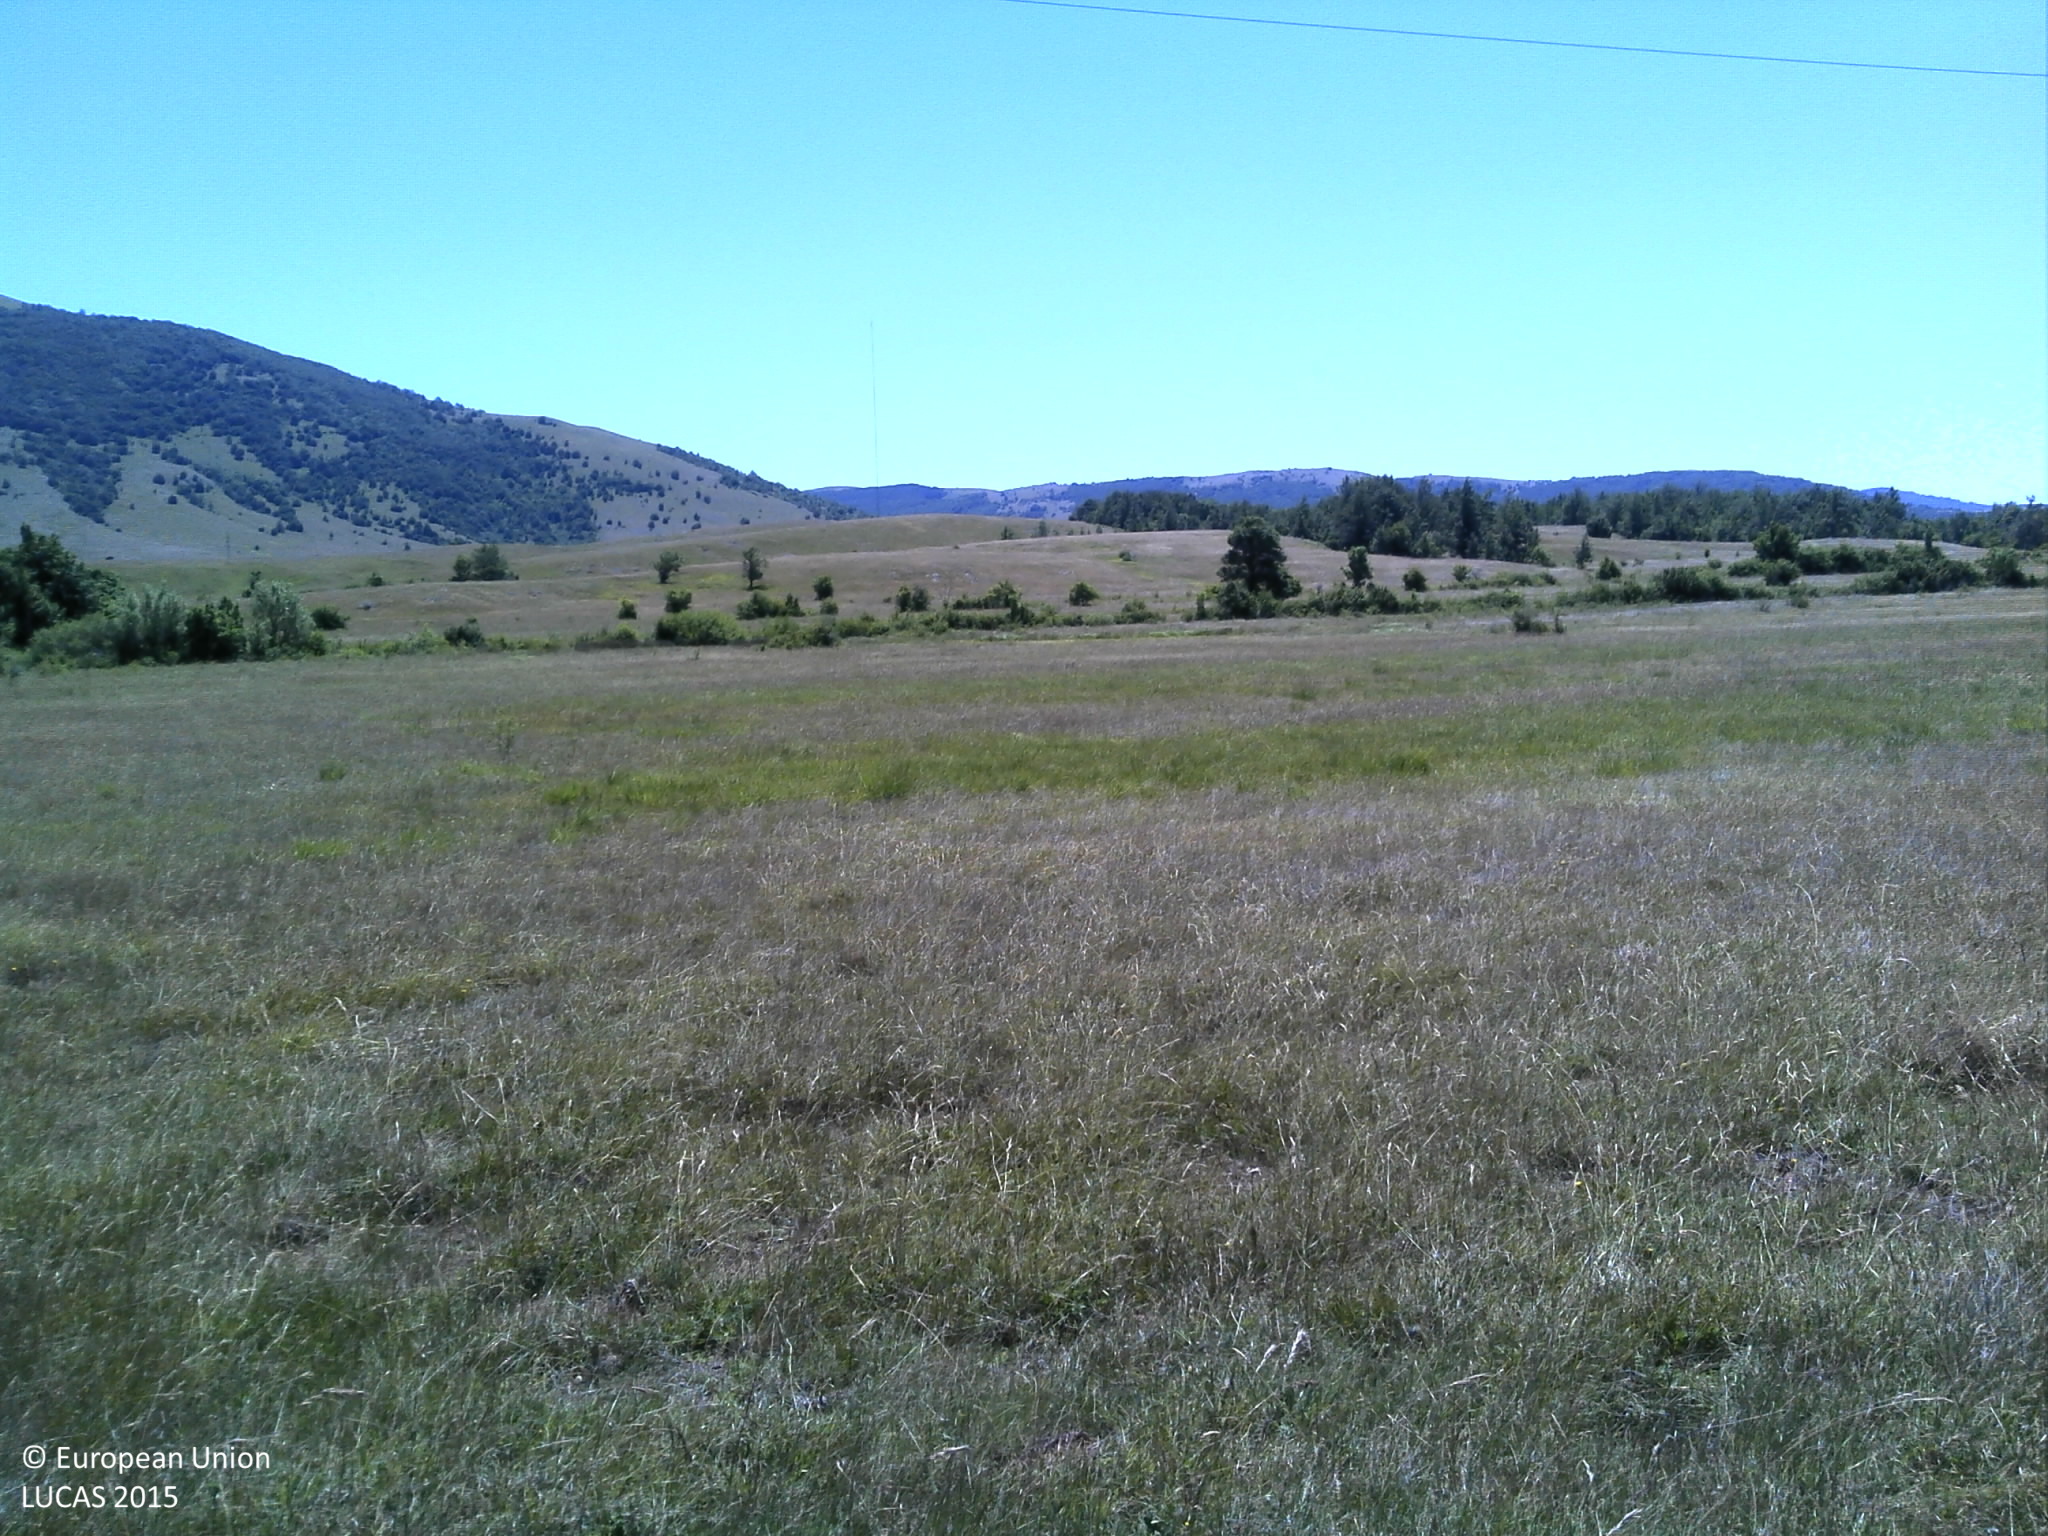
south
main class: Grassland
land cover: Grassland without tree/shrub cover
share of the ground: > 75 %
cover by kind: herbaceous plants 95 %, shrubs 5 %
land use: Agriculture (excluding fallow land and kitchen gardens)
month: July
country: HR
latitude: 44.4172
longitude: 15.9089
